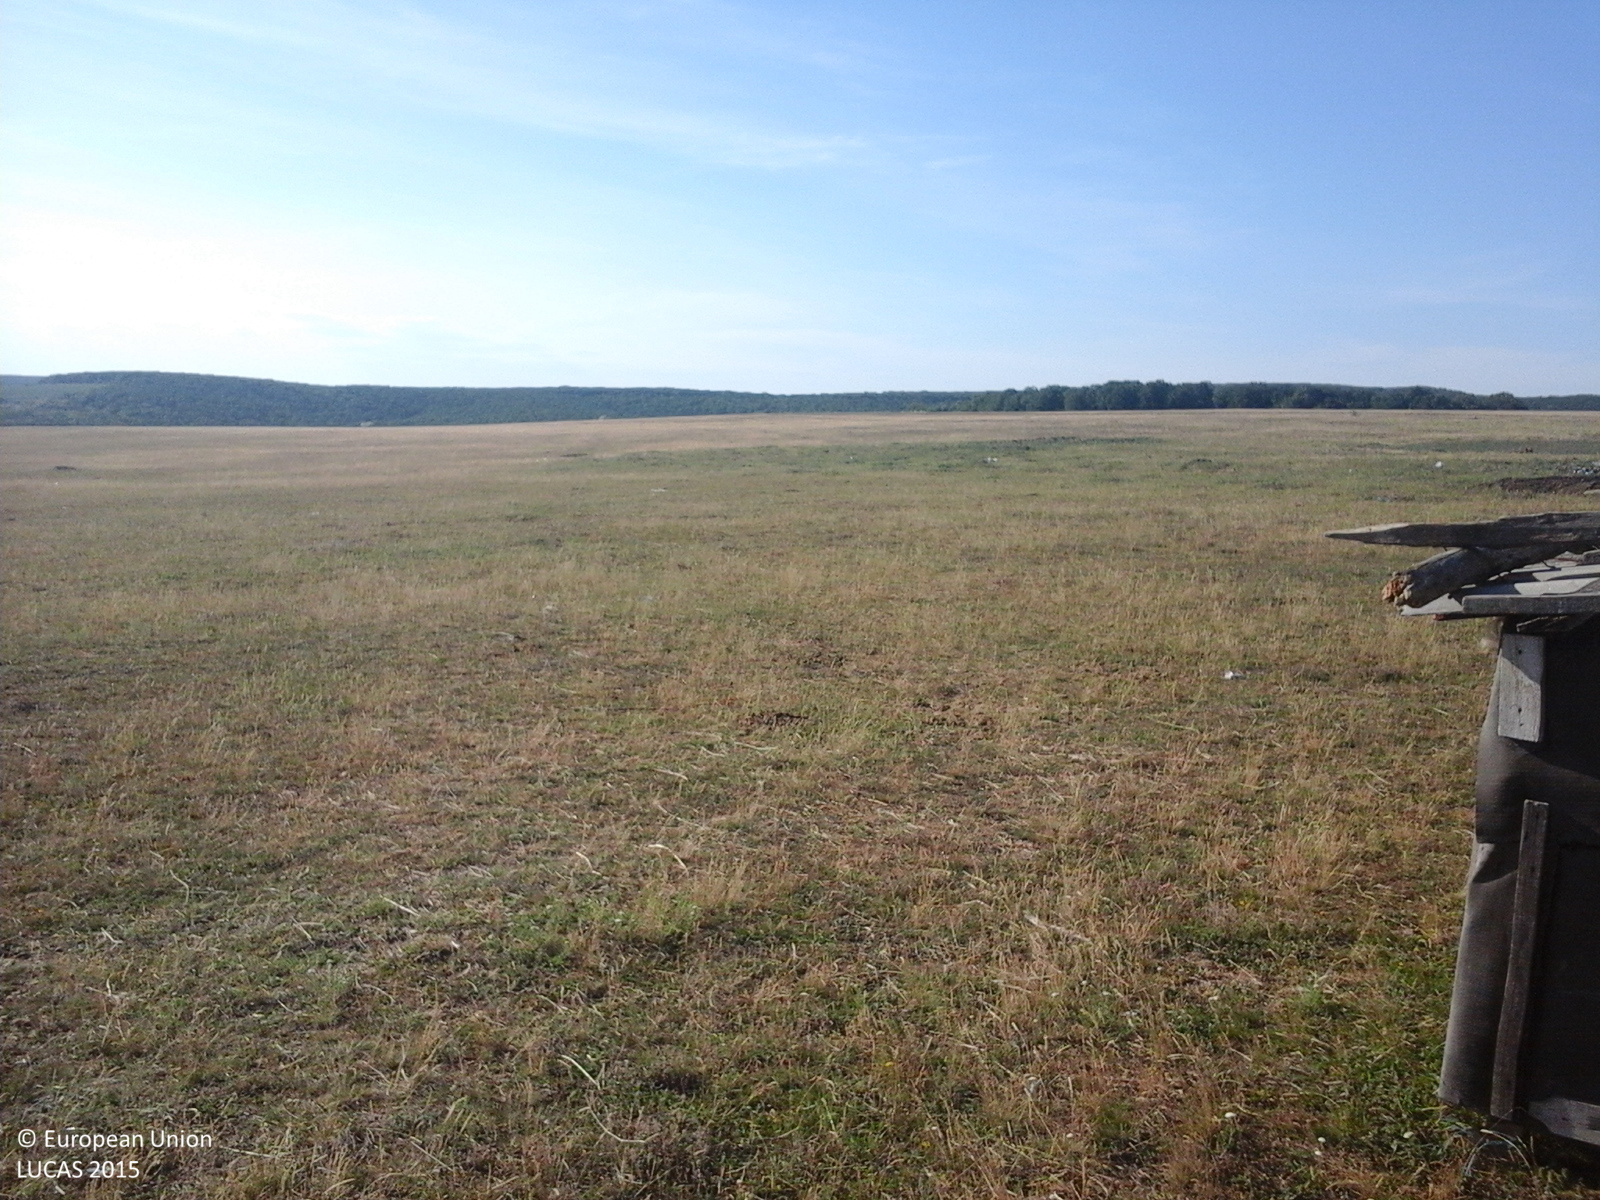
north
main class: Grassland
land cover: Grassland without tree/shrub cover
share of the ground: 25 - 50 %
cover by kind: unconsolidated bare surface 60 %, herbaceous plants 40 %
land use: Agriculture (excluding fallow land and kitchen gardens)
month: June
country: RO
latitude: 47.6702
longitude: 26.9503
